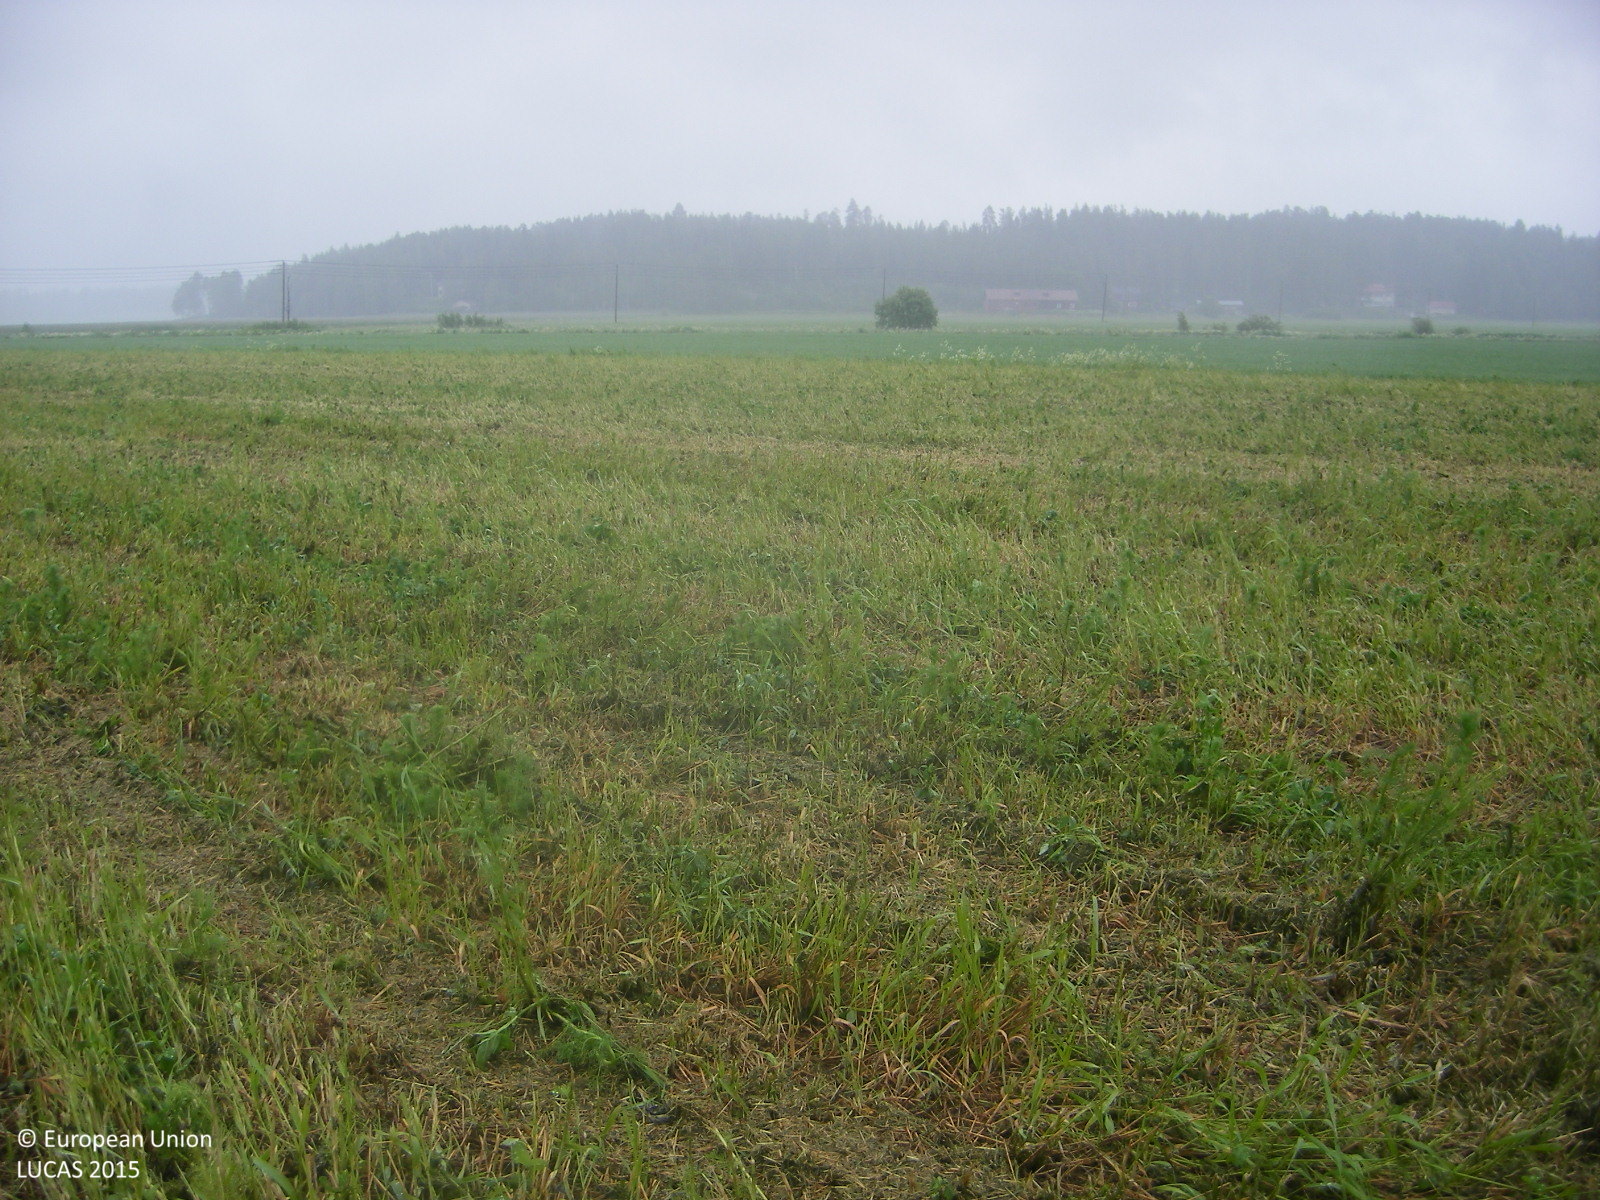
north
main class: Cropland
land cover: Other leguminous and mixtures for fodder
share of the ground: > 75 %
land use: Agriculture (excluding fallow land and kitchen gardens)
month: June
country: FI
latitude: 60.1144
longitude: 24.2273
